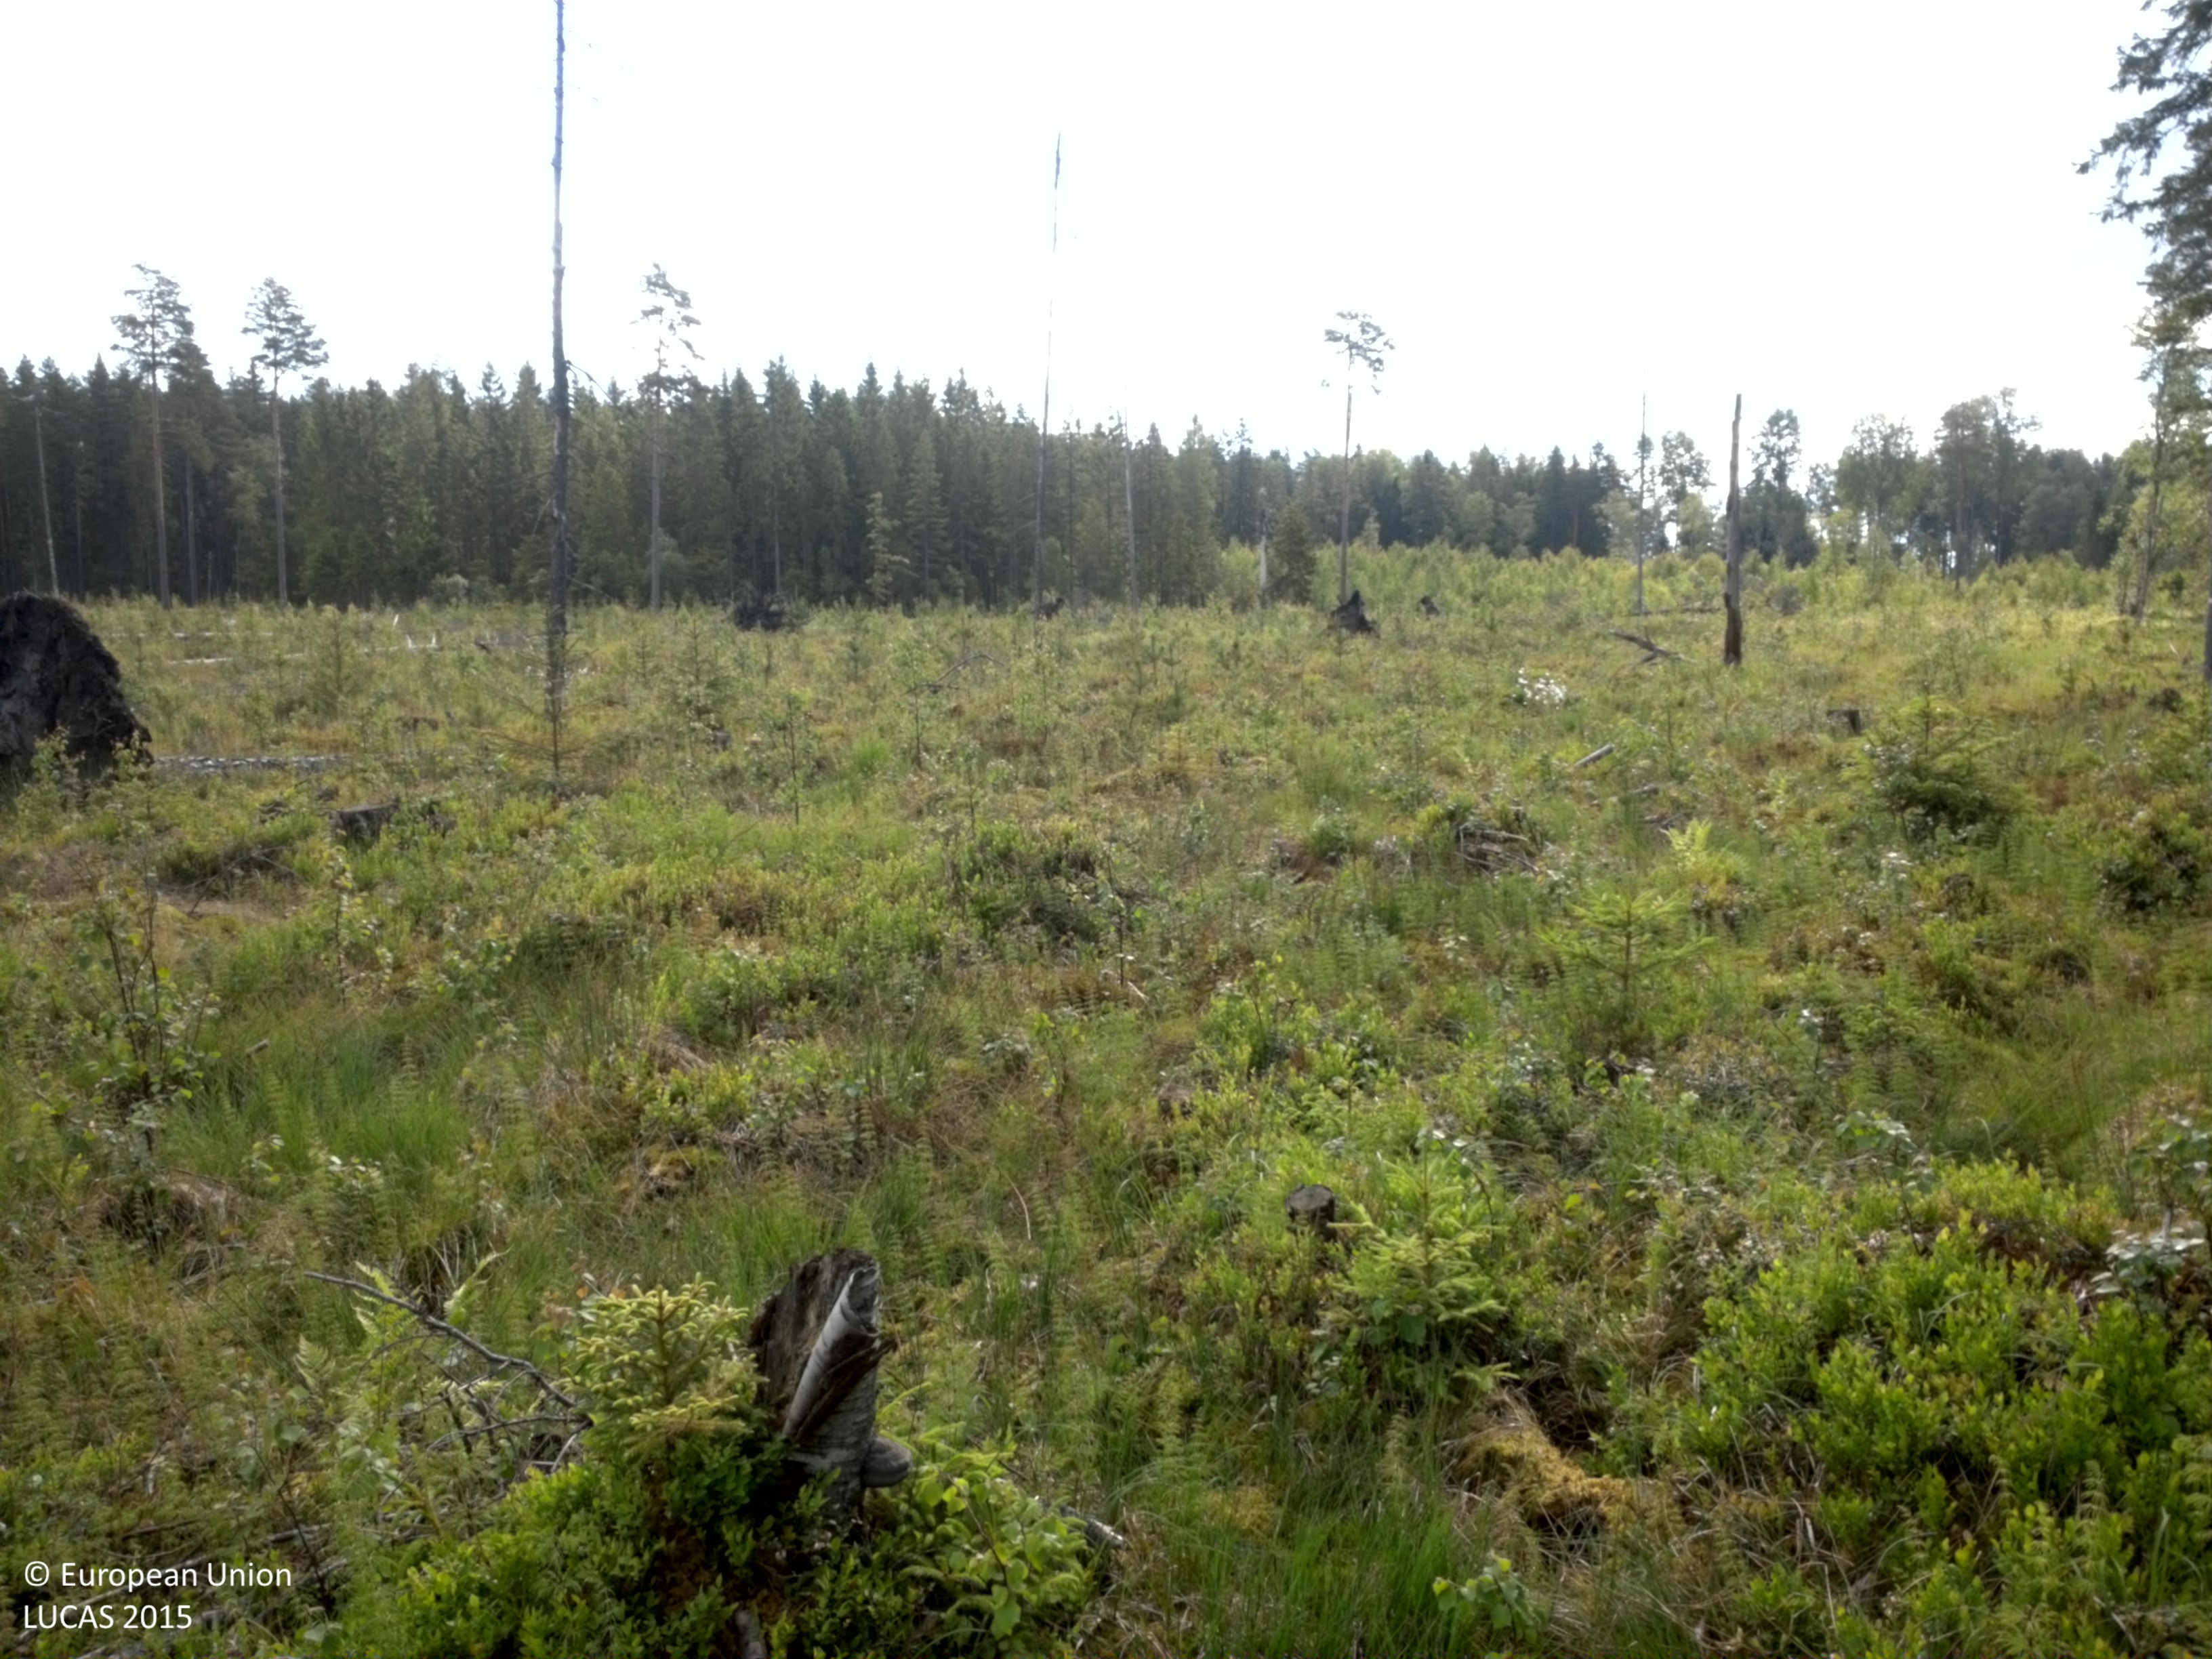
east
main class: Woodland
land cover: Spruce dominated mixed woodland
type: boreal forest
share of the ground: 10 - 25 %
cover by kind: herbaceous plants 40 %, lichens and mosses 40 %, coniferous forest trees 15 %, broadleaved forest trees 5 %
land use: Forestry
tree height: < 5 m
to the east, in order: Spruce dominated mixed woodland; Pine dominated mixed woodland; Broadleaved woodland
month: June
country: SE
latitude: 59.9261
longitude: 17.1665
